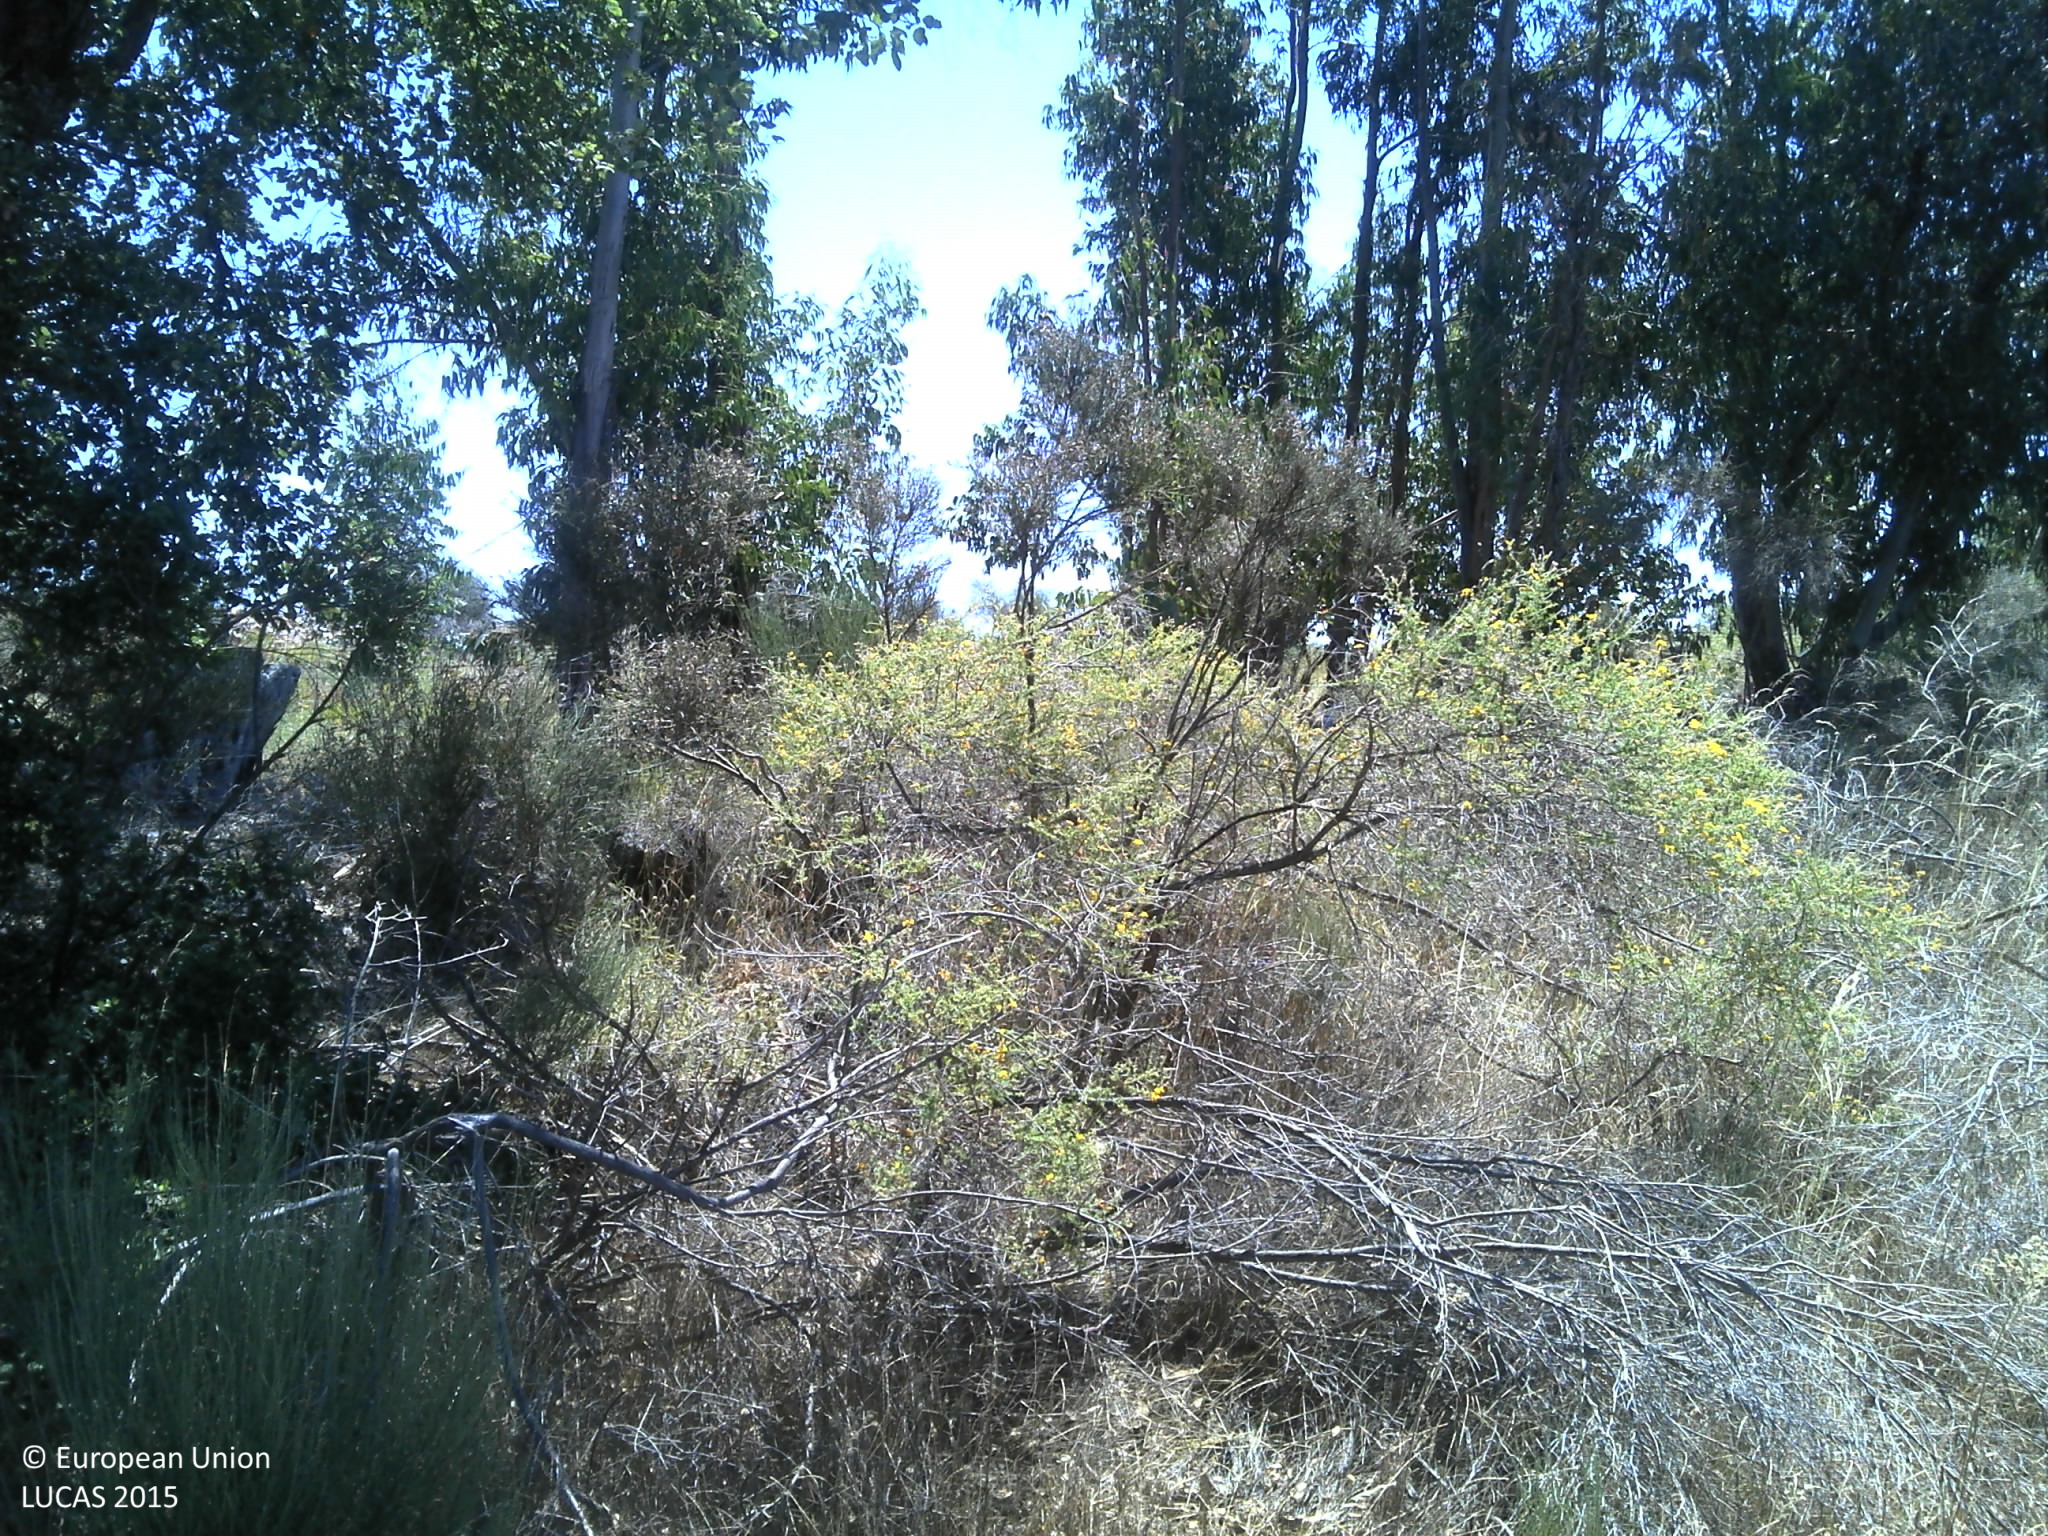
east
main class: Shrubland
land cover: Shrubland with sparse tree cover
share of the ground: 25 - 50 %
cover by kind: shrubs 40 %, herbaceous plants 40 %, unconsolidated bare surface 10 %, broadleaved forest trees 5 %
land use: Abandoned areas
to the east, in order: Shrubland with sparse tree cover; Dry stone walls; Fences; Pine dominated coniferous woodland; Fences; Dry stone walls; Olive groves; Tracks; Fences; Tracks; Dry stone walls; Olive groves; Other bare soil
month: June
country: PT
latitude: 40.0035
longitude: -7.3294
